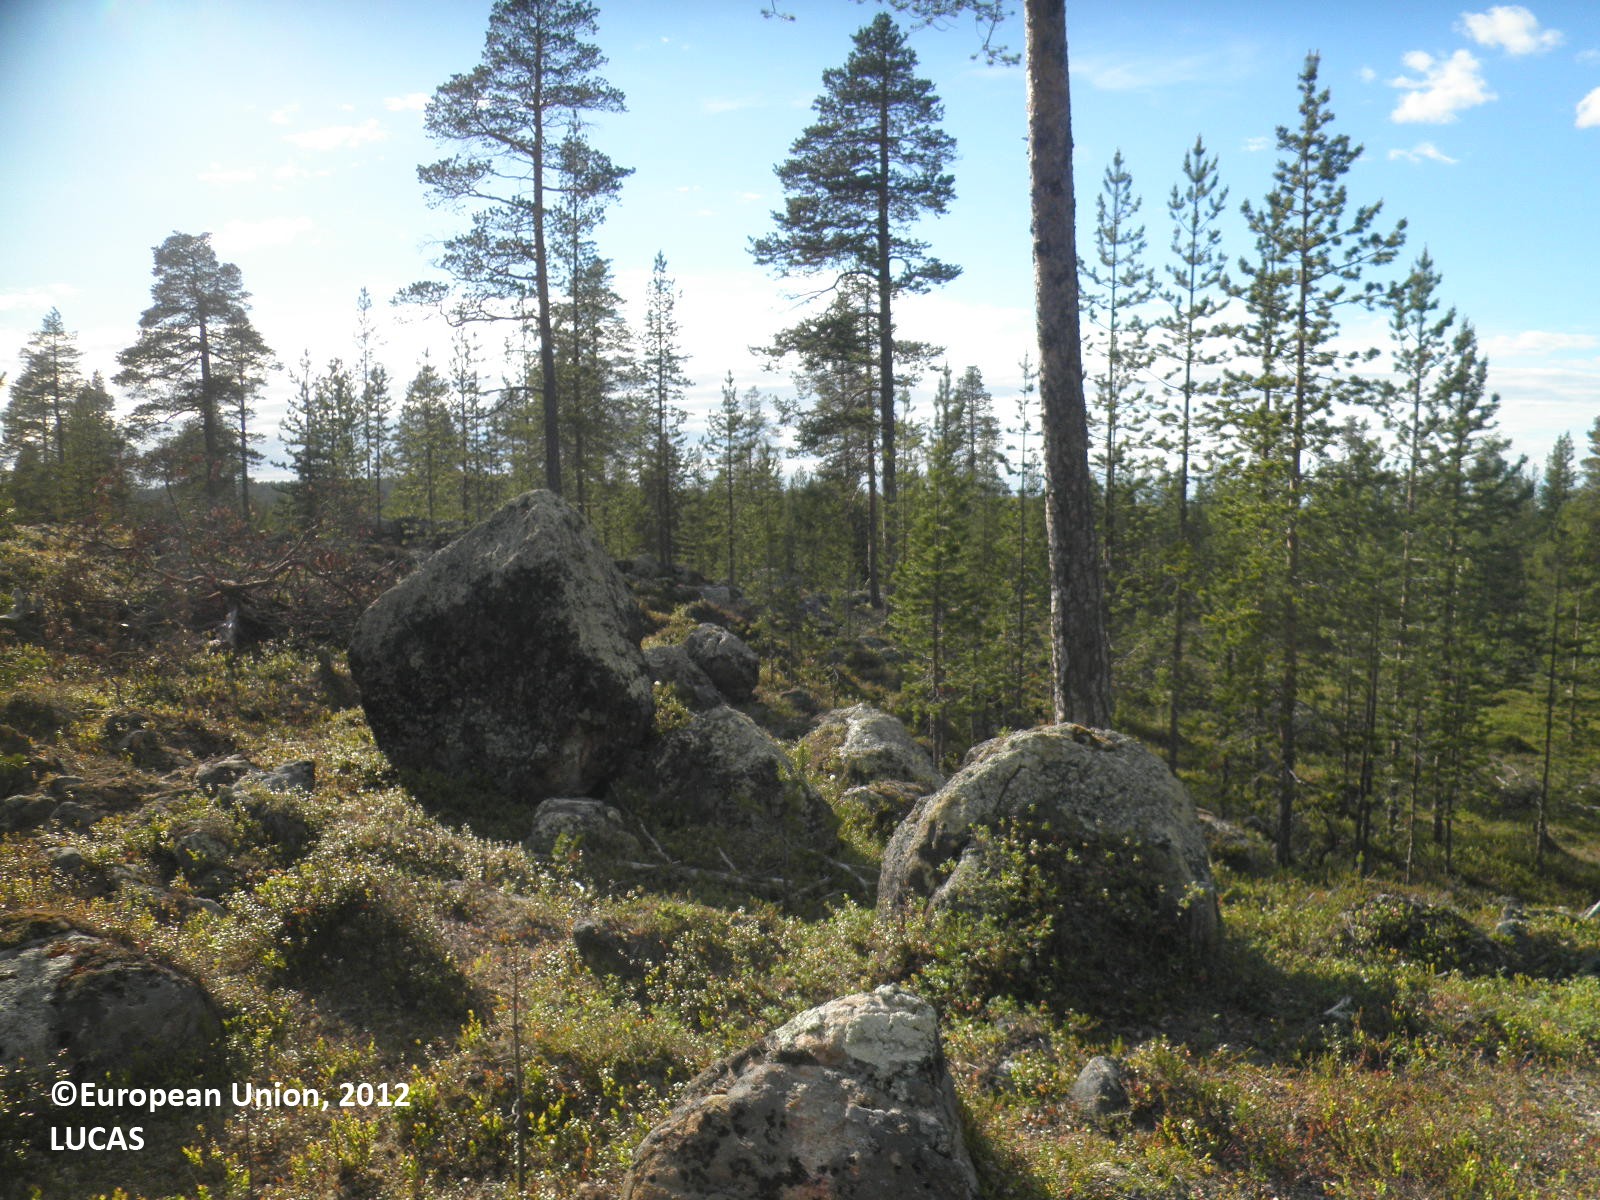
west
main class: Woodland
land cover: Pine dominated coniferous woodland
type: boreal forest
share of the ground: 10 - 25 %
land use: Forestry
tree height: > 5 m
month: July
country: FI
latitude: 68.8843
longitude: 27.1003
